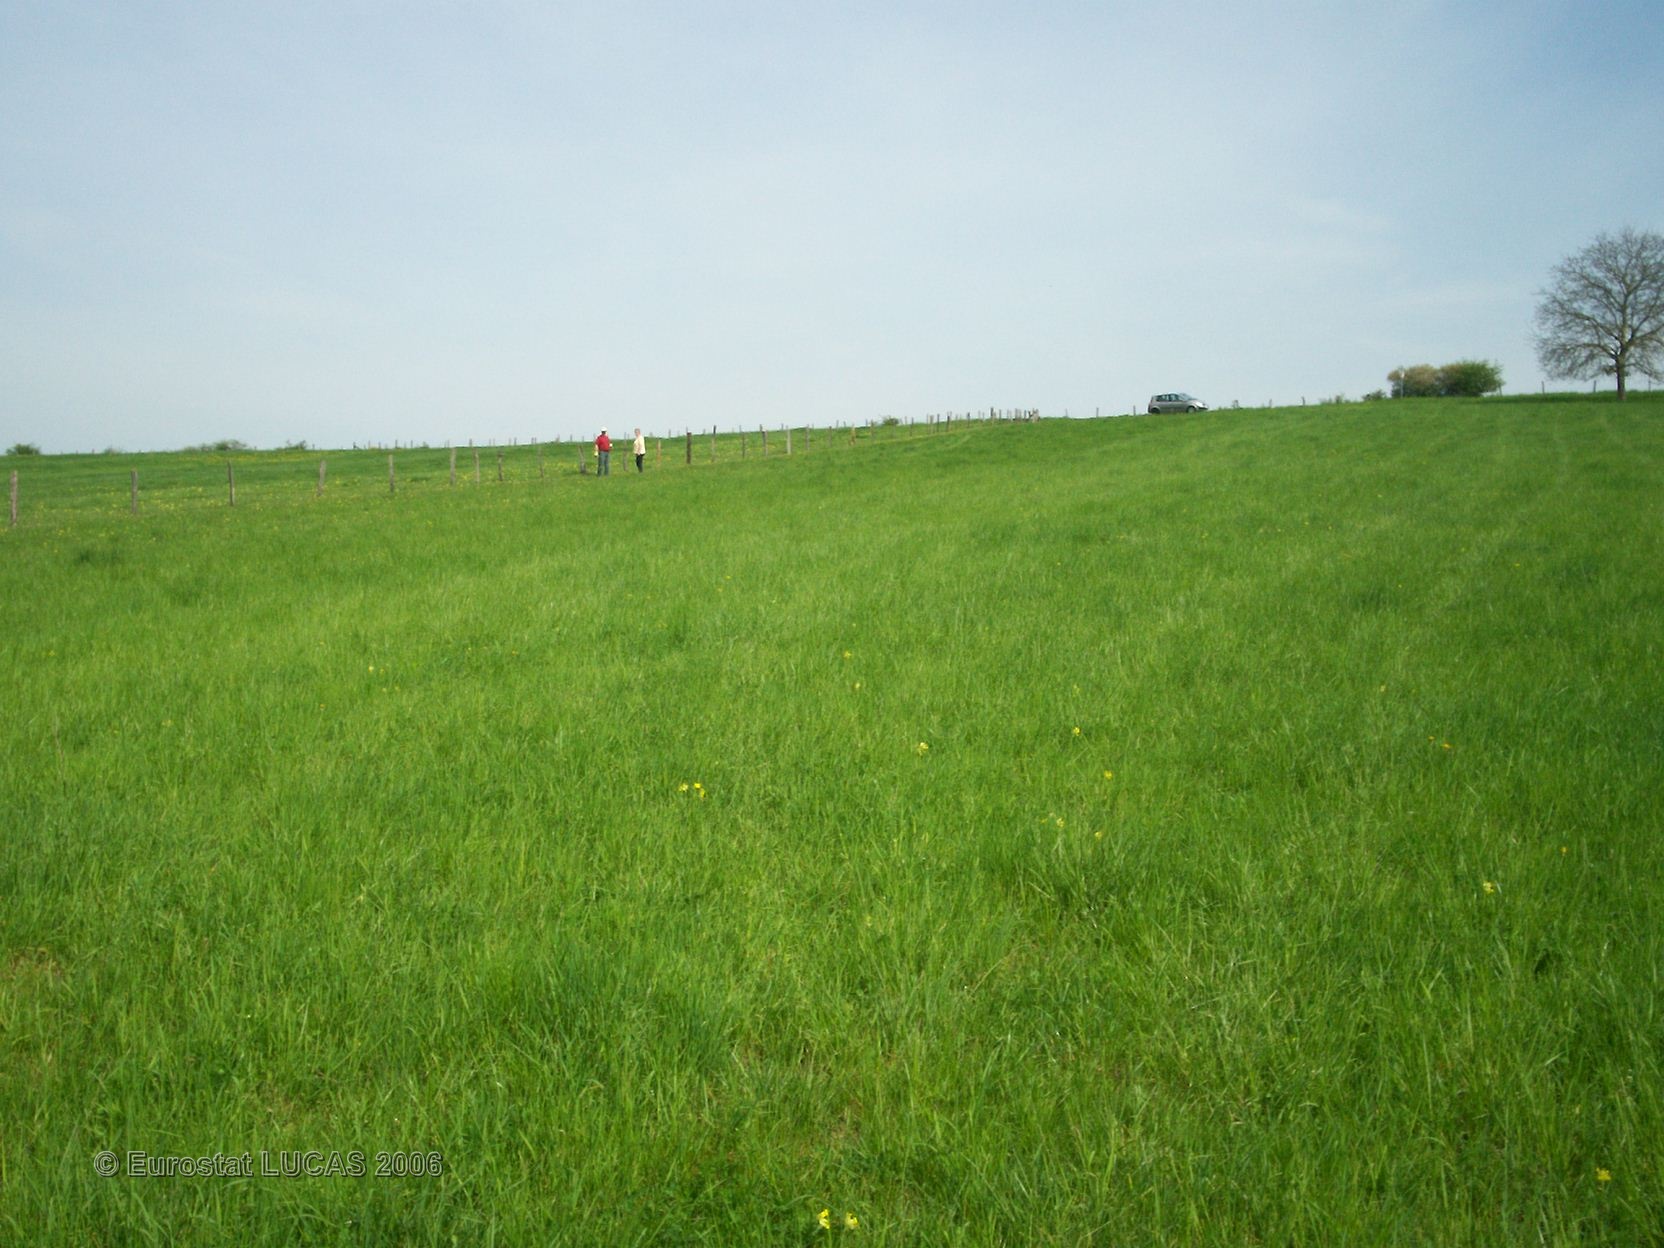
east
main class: Grassland
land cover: Grassland without tree/shrub cover
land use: Agriculture (excluding fallow land and kitchen gardens)
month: May
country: FR
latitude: 49.0665
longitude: 7.0577
